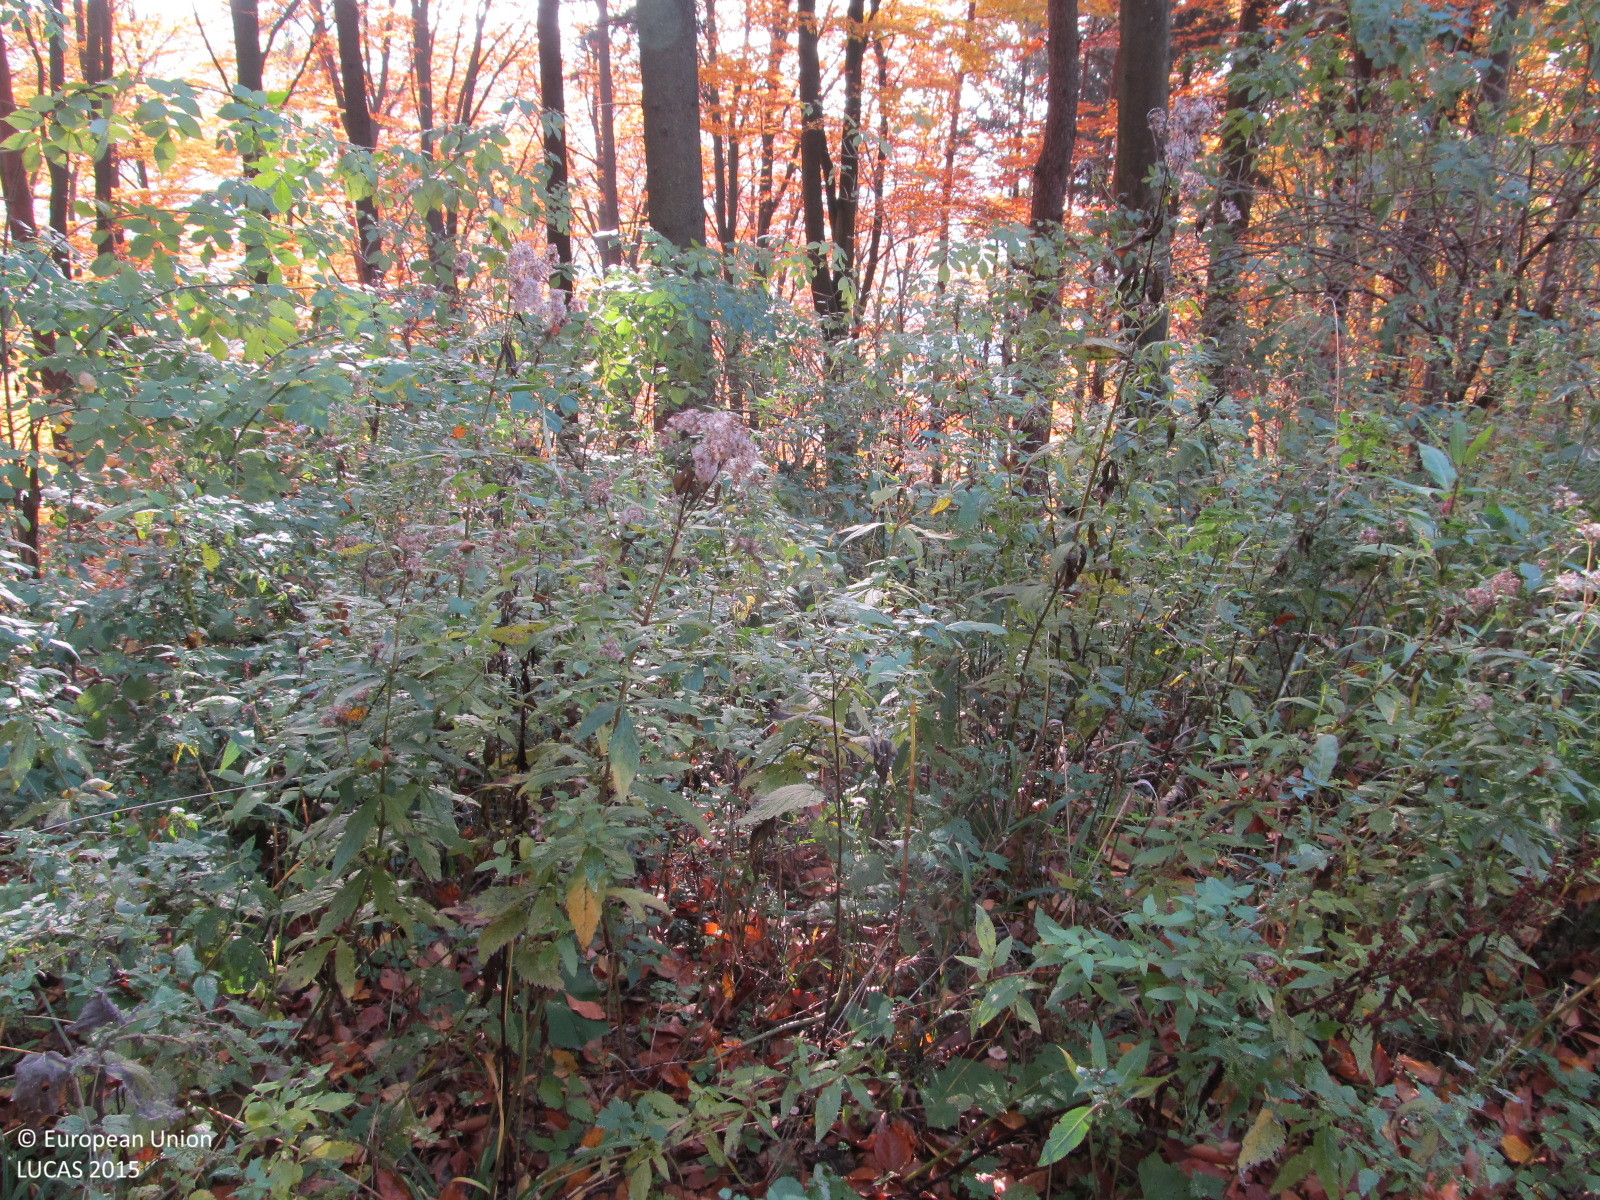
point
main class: Woodland
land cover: Spruce dominated mixed woodland
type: hemiboreal forest and nemoral coniferous forest and mixed broadleaved-coniferous forest
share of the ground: > 75 %
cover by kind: broadleaved forest trees 50 %, coniferous forest trees 30 %, shrubs 15 %, herbaceous plants 5 %
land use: Forestry
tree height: > 5 m
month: October
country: AT
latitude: 48.2507
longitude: 15.4568
